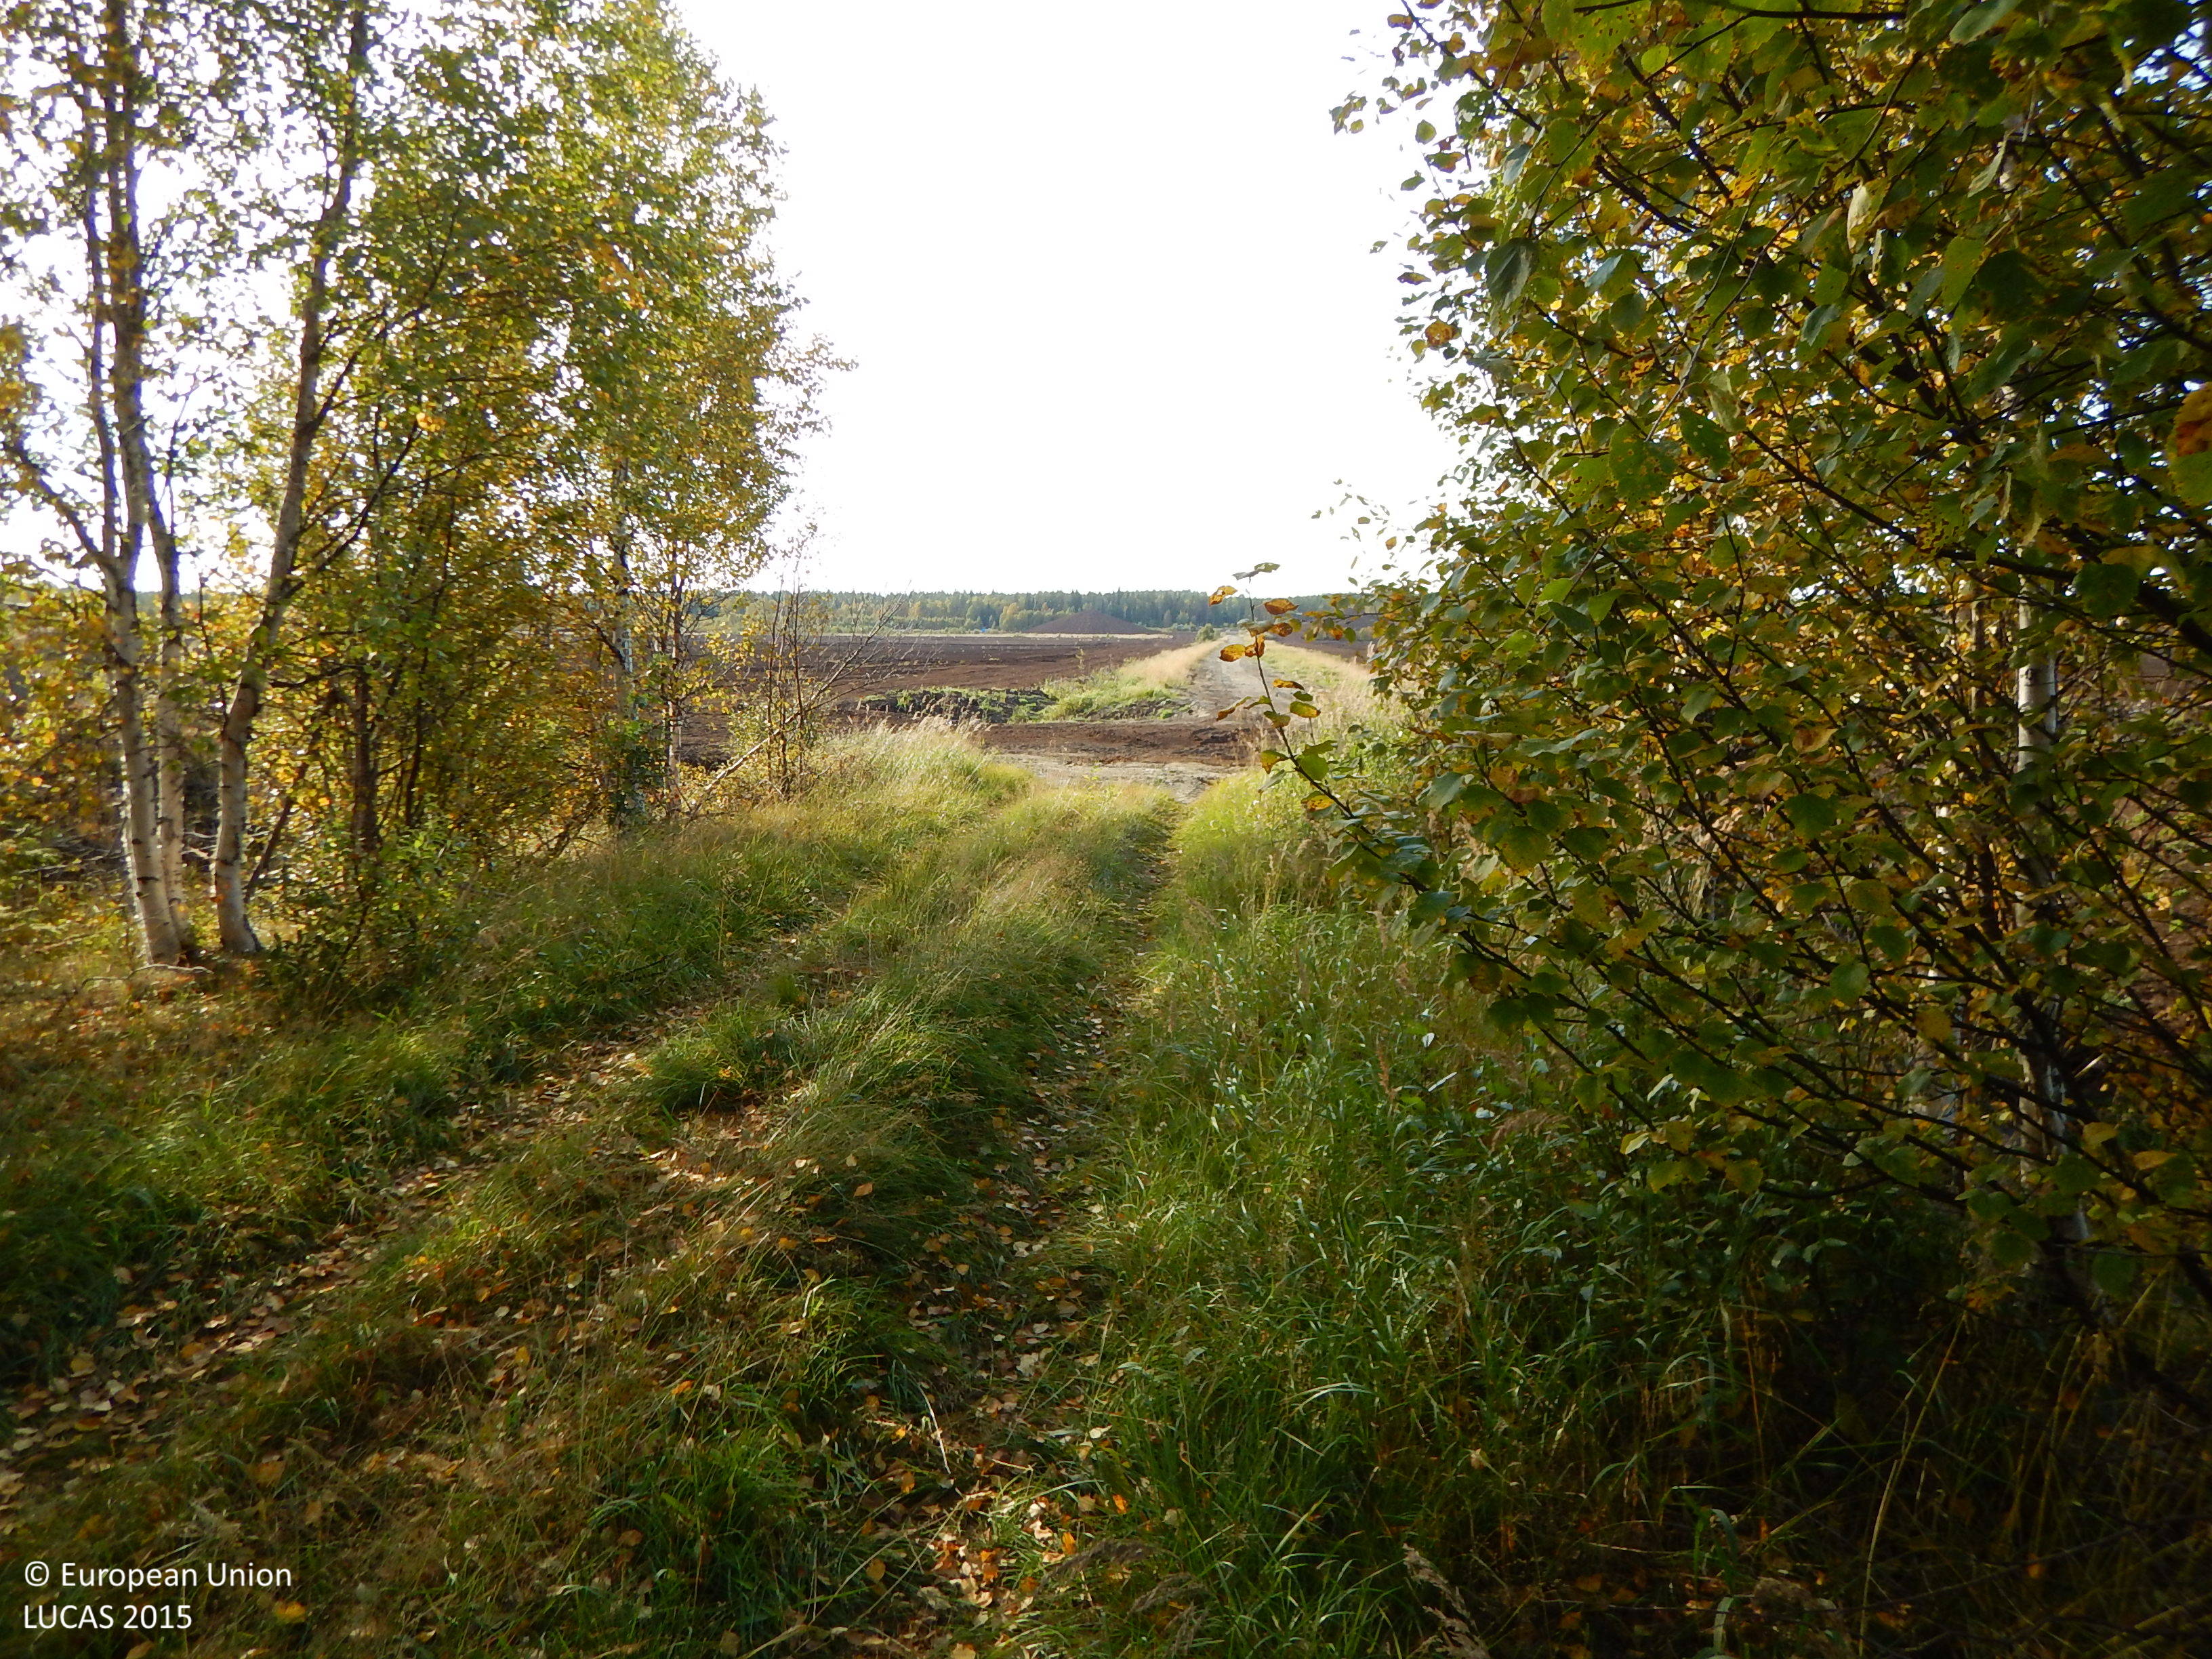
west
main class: Woodland
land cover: Pine dominated mixed woodland
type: boreal forest
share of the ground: 50 - 75 %
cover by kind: coniferous forest trees 40 %, broadleaved forest trees 20 %, shrubs 15 %, lichens and mosses 15 %, herbaceous plants 10 %
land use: Forestry
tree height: > 5 m
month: September
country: SE
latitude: 64.7055
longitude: 20.2308
